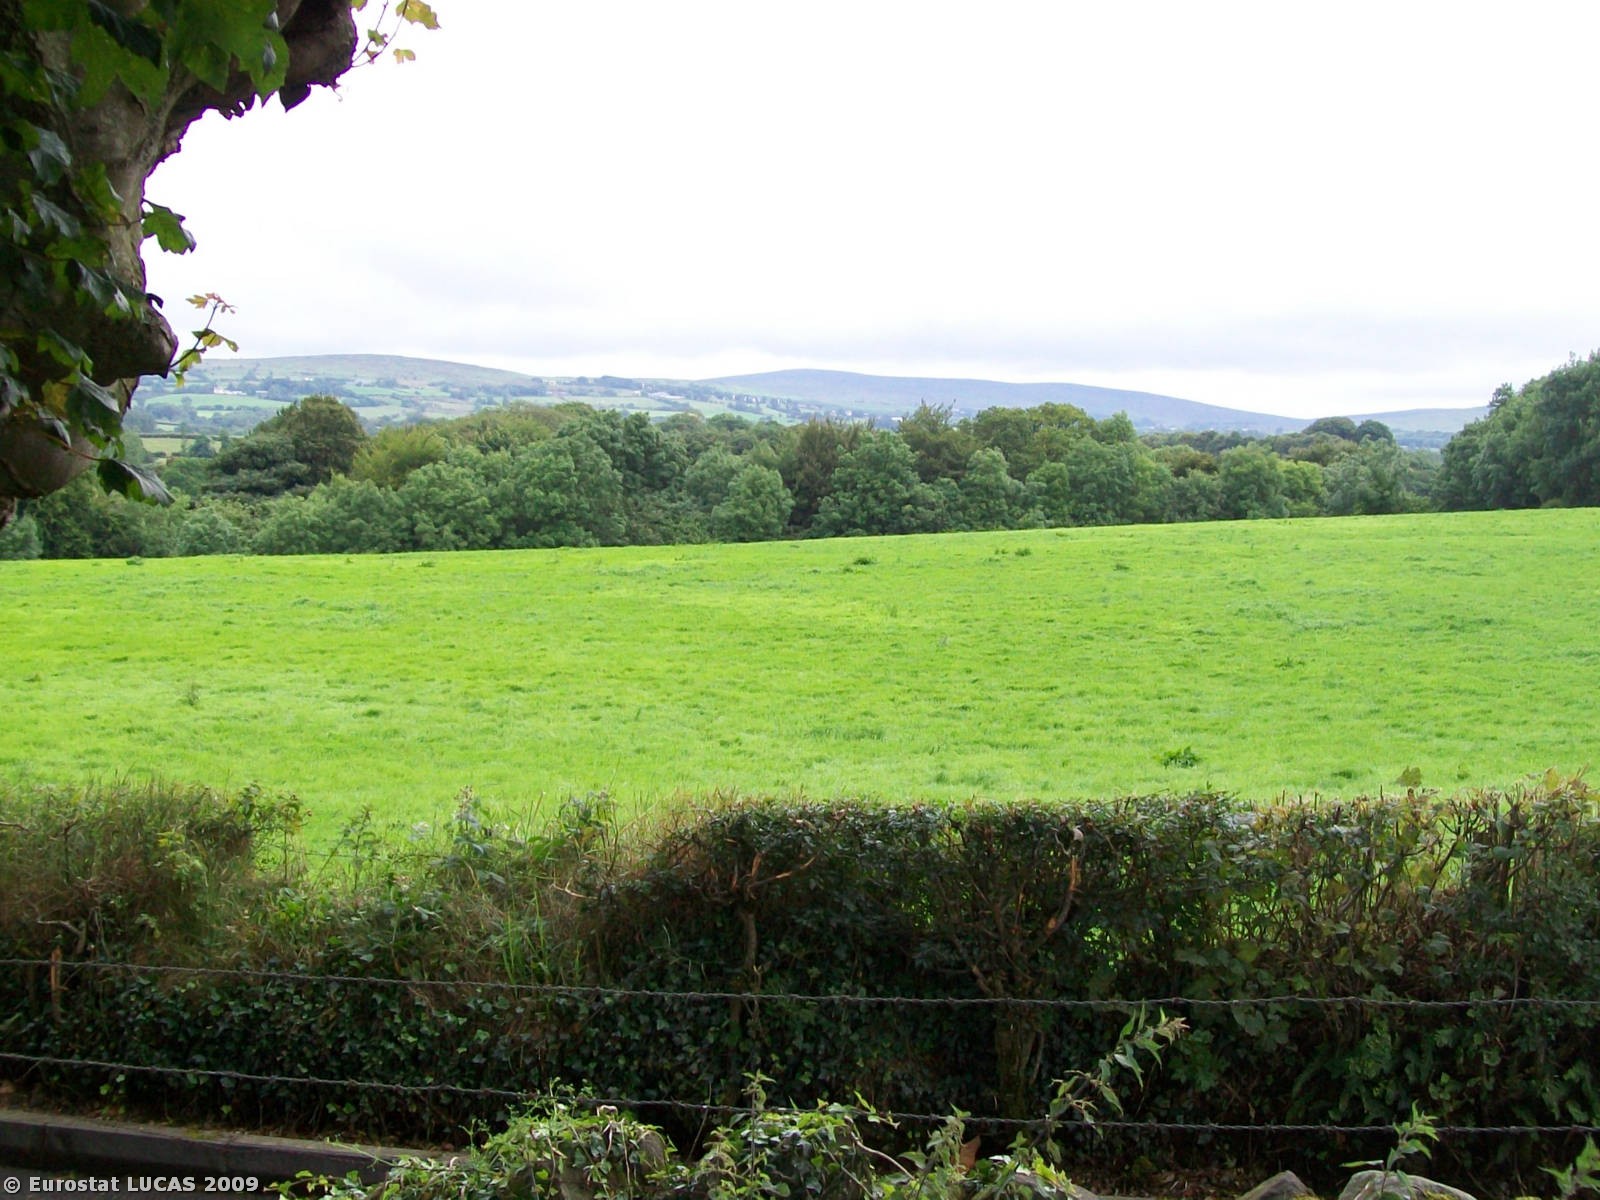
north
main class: Grassland
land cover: Grassland with sparse tree/shrub cover
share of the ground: > 75 %
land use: Agriculture (excluding fallow land and kitchen gardens)
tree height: > 5 m
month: July
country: GB
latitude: 54.8921
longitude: -6.1884
